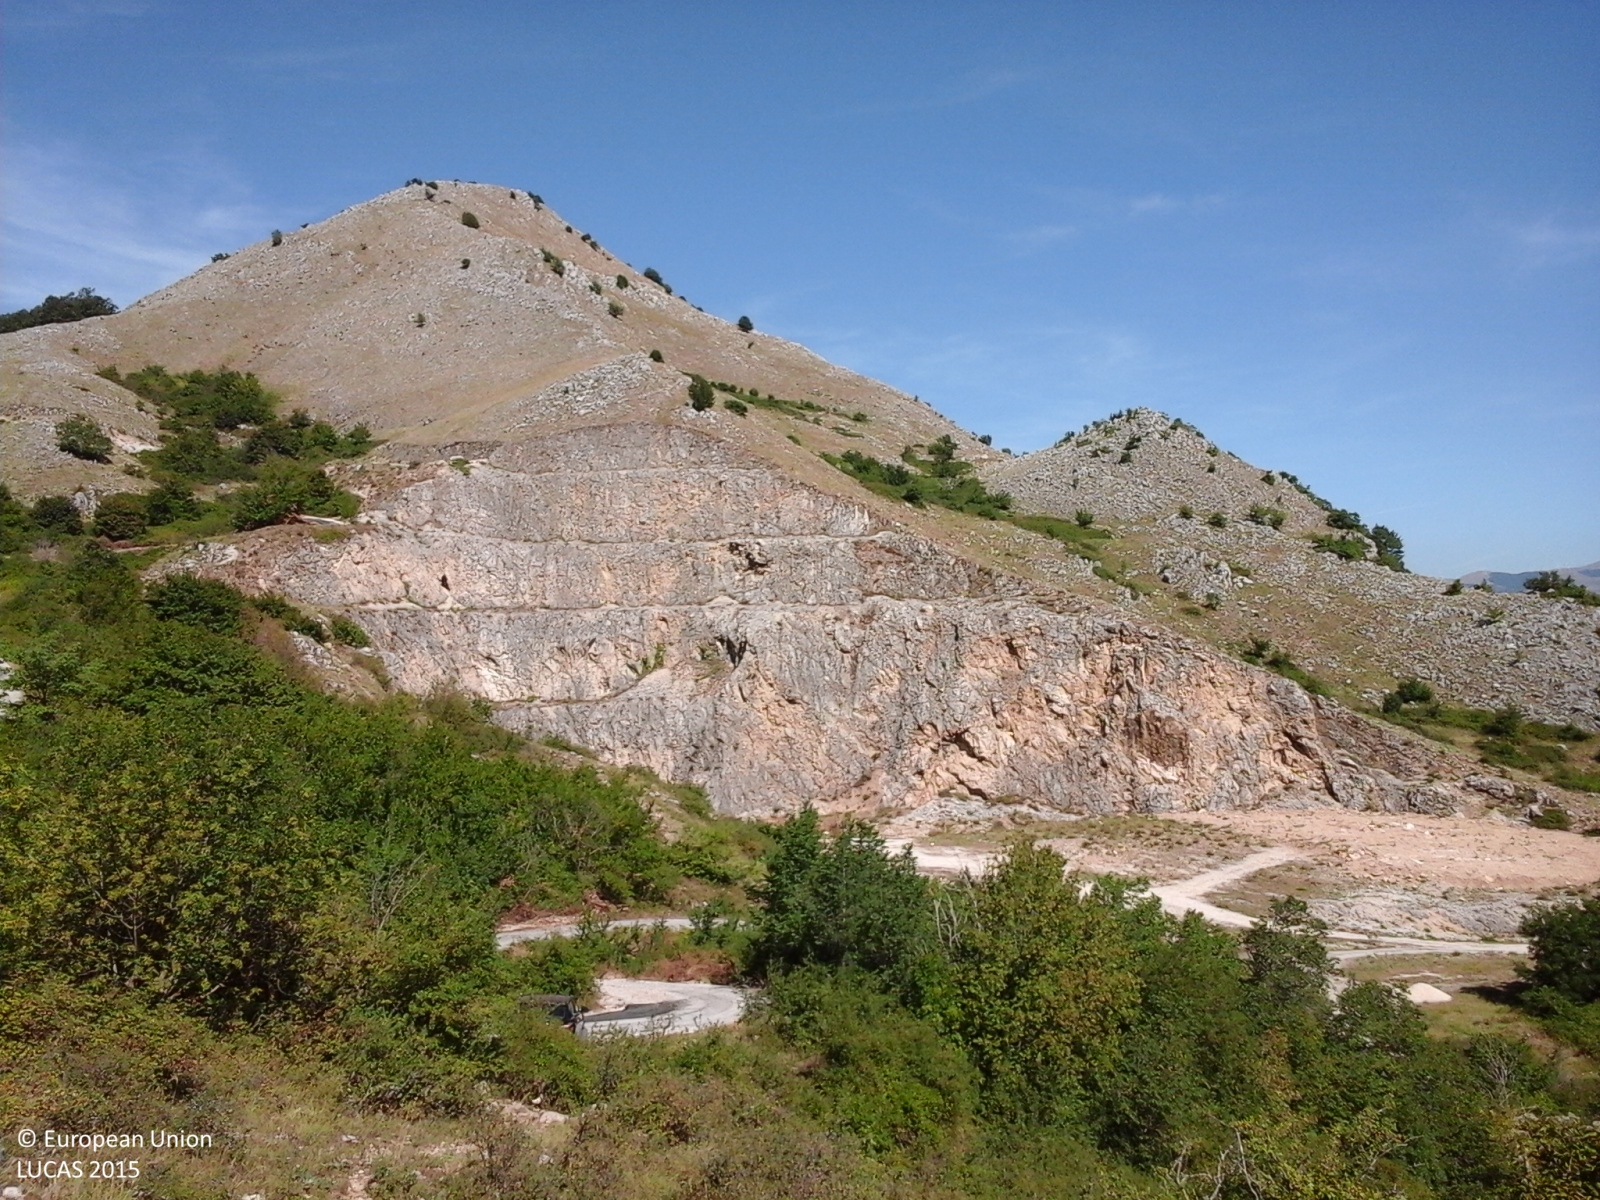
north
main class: Woodland
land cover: Broadleaved woodland
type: thermophilous deciduous forest
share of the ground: > 75 %
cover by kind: broadleaved forest trees 85 %, shrubs 10 %, herbaceous plants 5 %
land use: Semi-natural and natural areas not in use
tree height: > 5 m
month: July
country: IT
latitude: 41.4695
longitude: 14.4740
